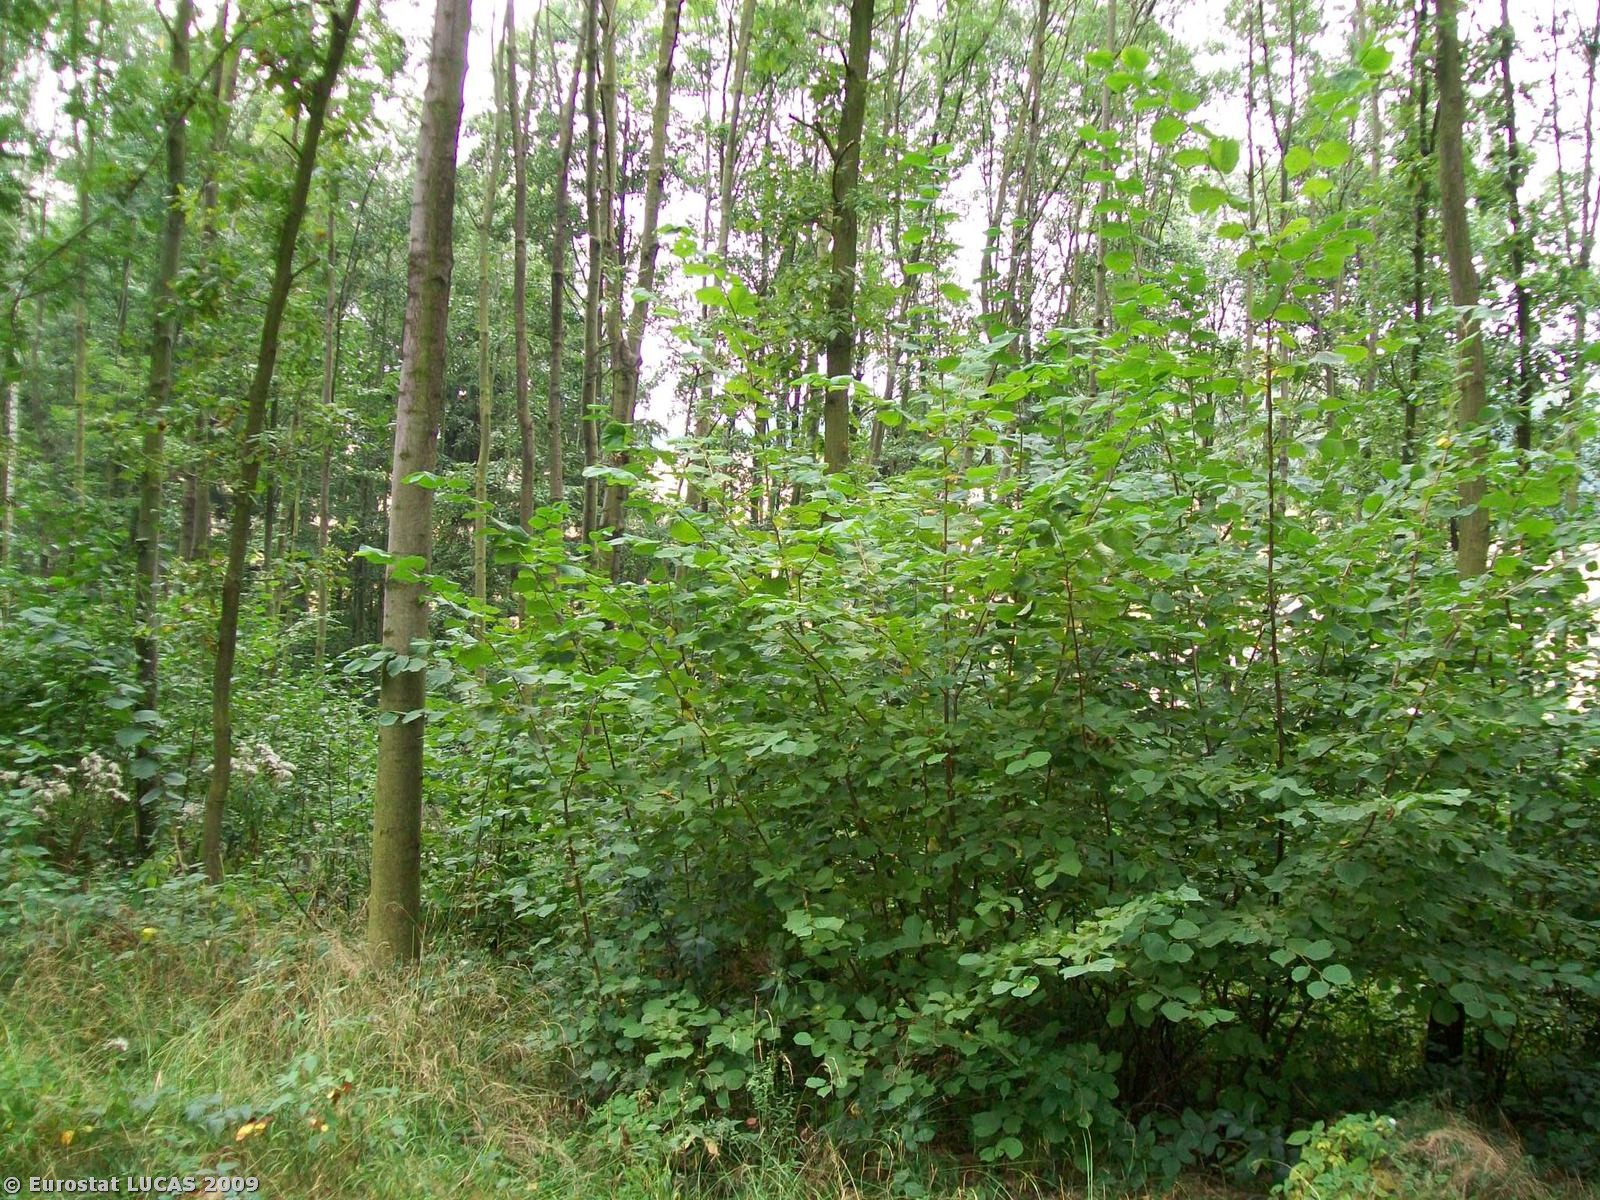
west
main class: Woodland
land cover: Mixed woodland
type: hemiboreal forest and nemoral coniferous forest and mixed broadleaved-coniferous forest
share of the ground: > 75 %
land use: Unused
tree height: > 5 m
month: September
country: PL
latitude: 50.4025
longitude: 17.2853
